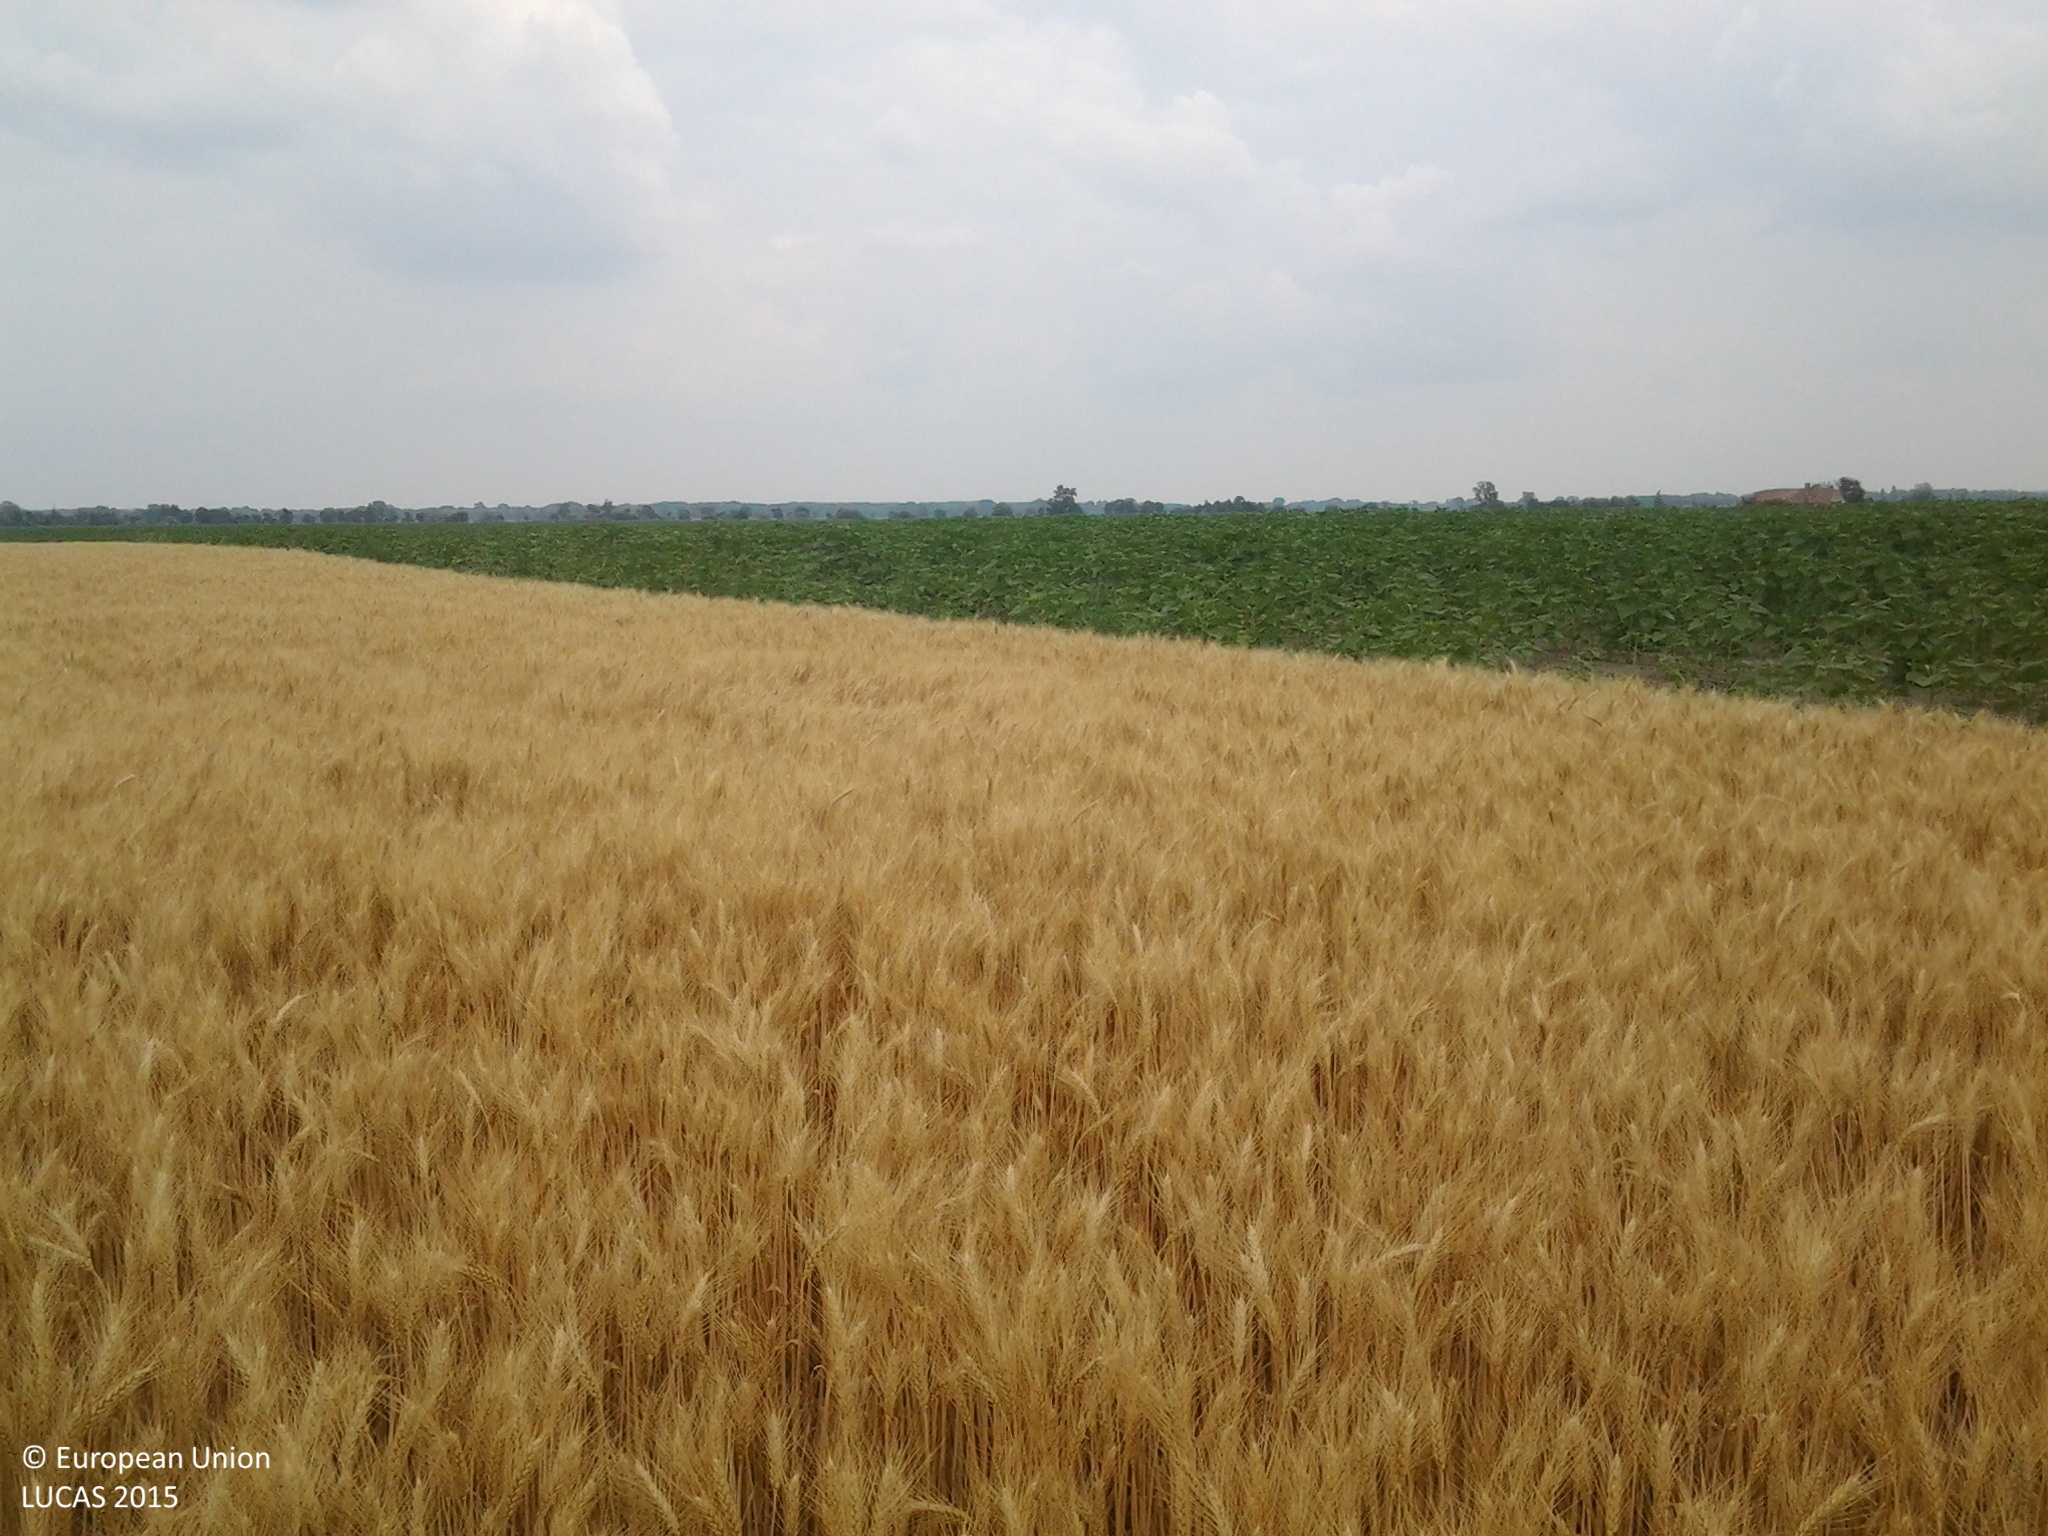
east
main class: Cropland
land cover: Common wheat
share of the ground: > 75 %
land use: Agriculture (excluding fallow land and kitchen gardens)
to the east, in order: Common wheat; Sunflower; Common wheat
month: June
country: HU
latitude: 46.8568
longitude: 19.2375
